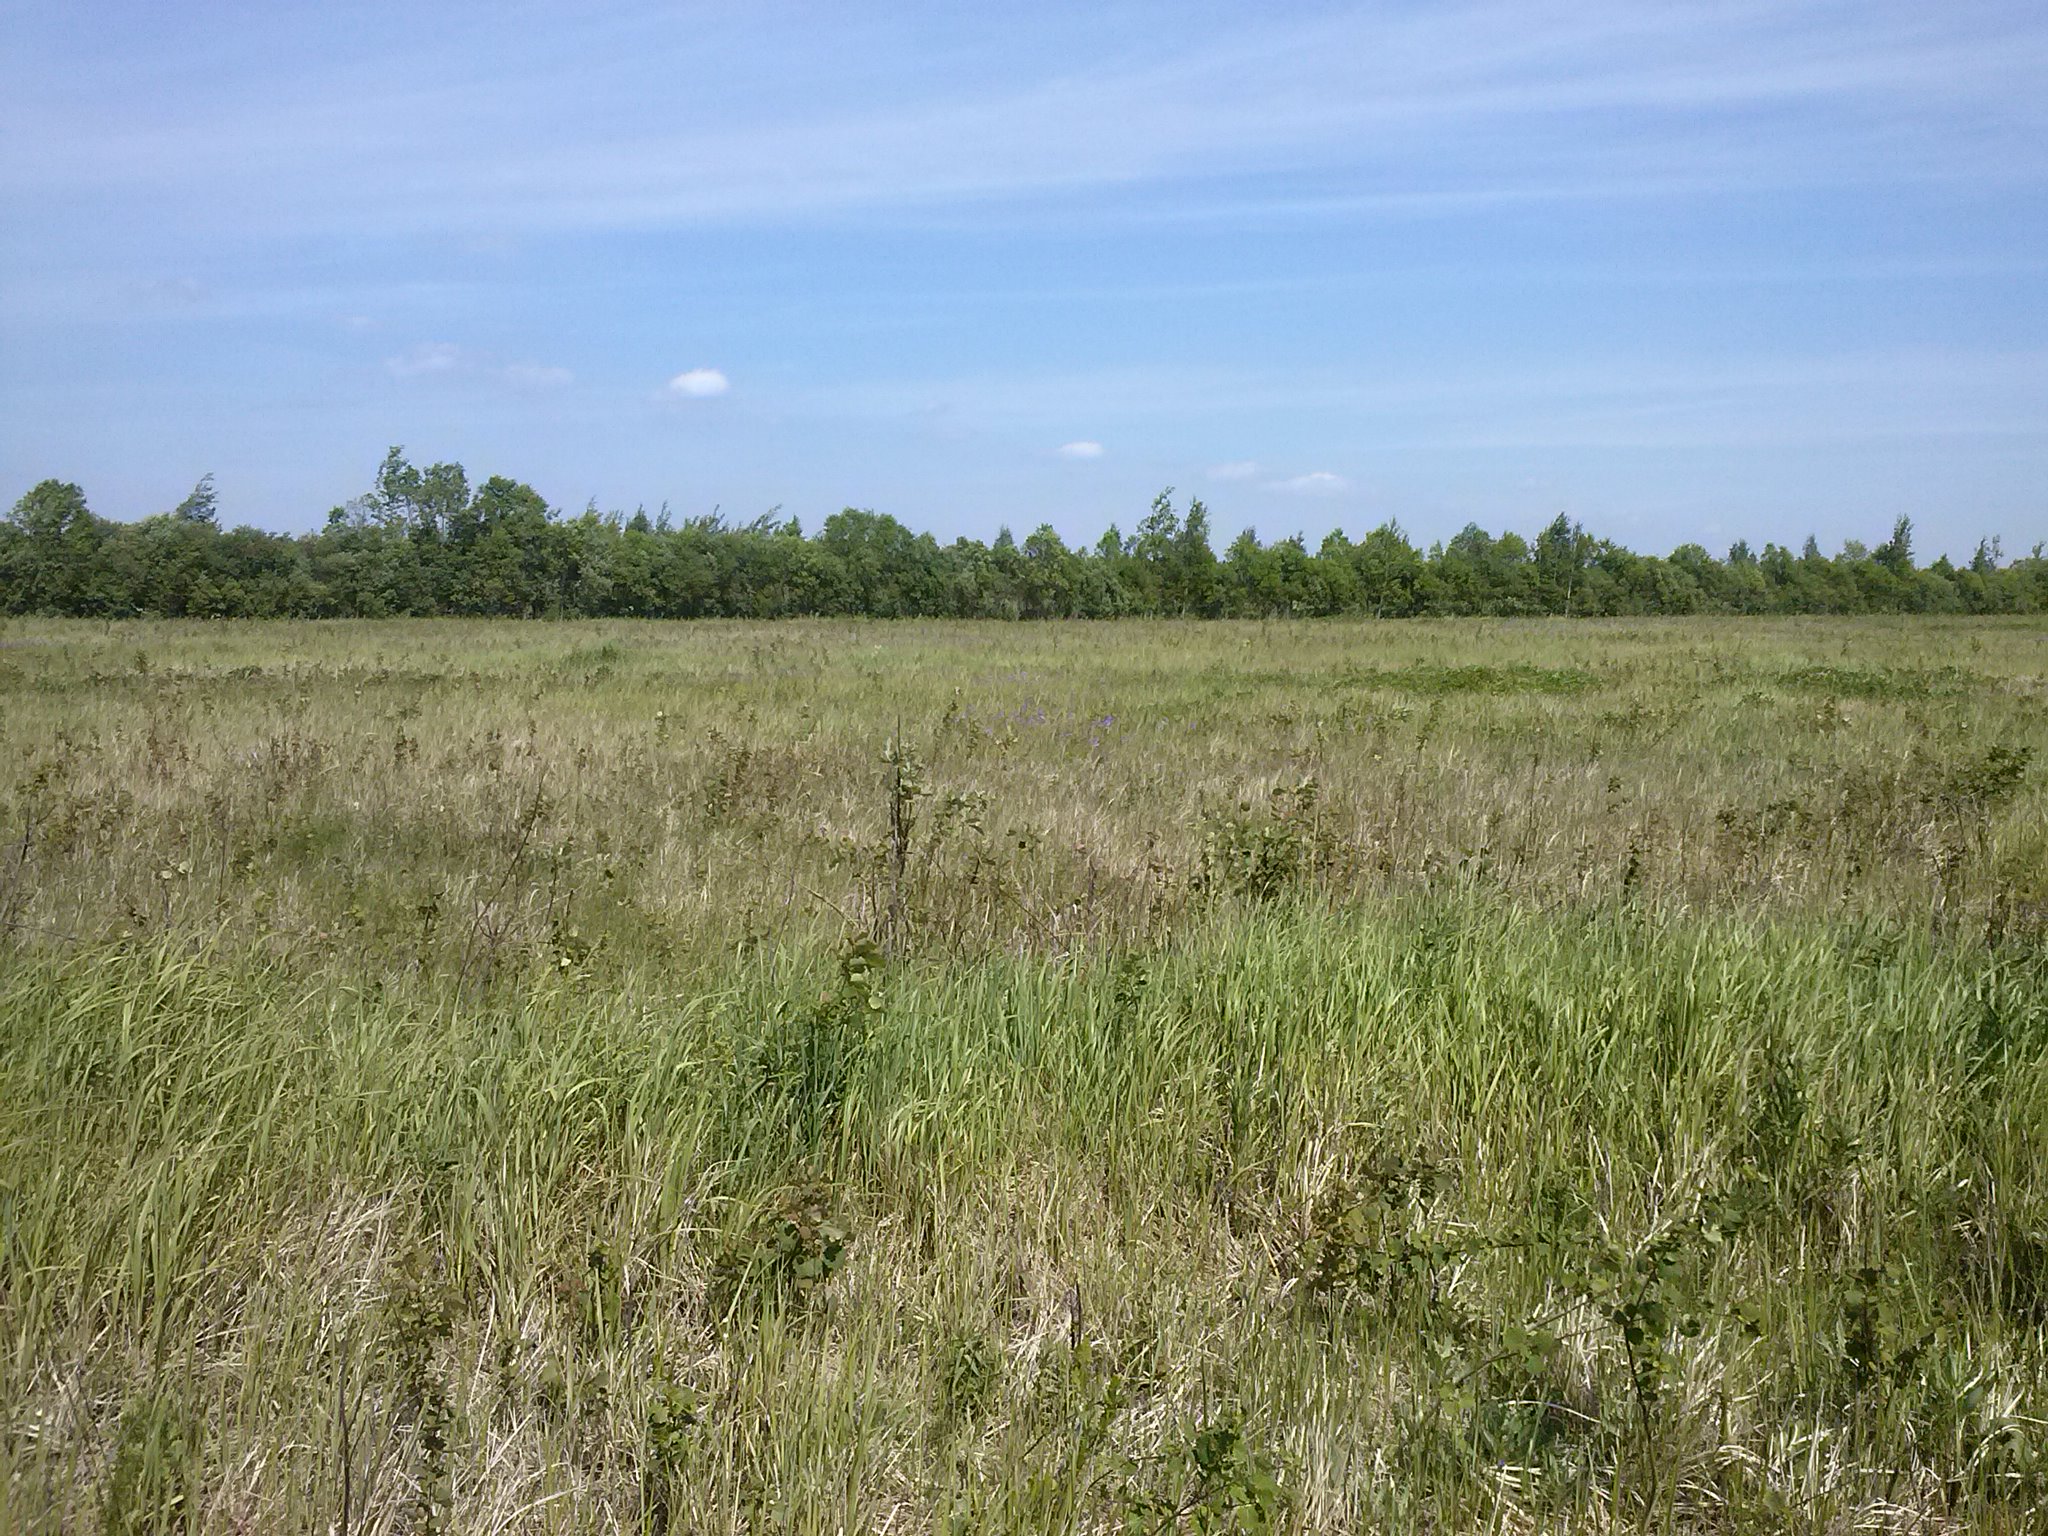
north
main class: Grassland
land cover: Grassland with sparse tree/shrub cover
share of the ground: > 75 %
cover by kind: herbaceous plants 85 %, shrubs 10 %, broadleaved forest trees 5 %
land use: Agriculture (excluding fallow land and kitchen gardens)
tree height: < 5 m
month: June
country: LV
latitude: 56.8254
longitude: 27.0234
